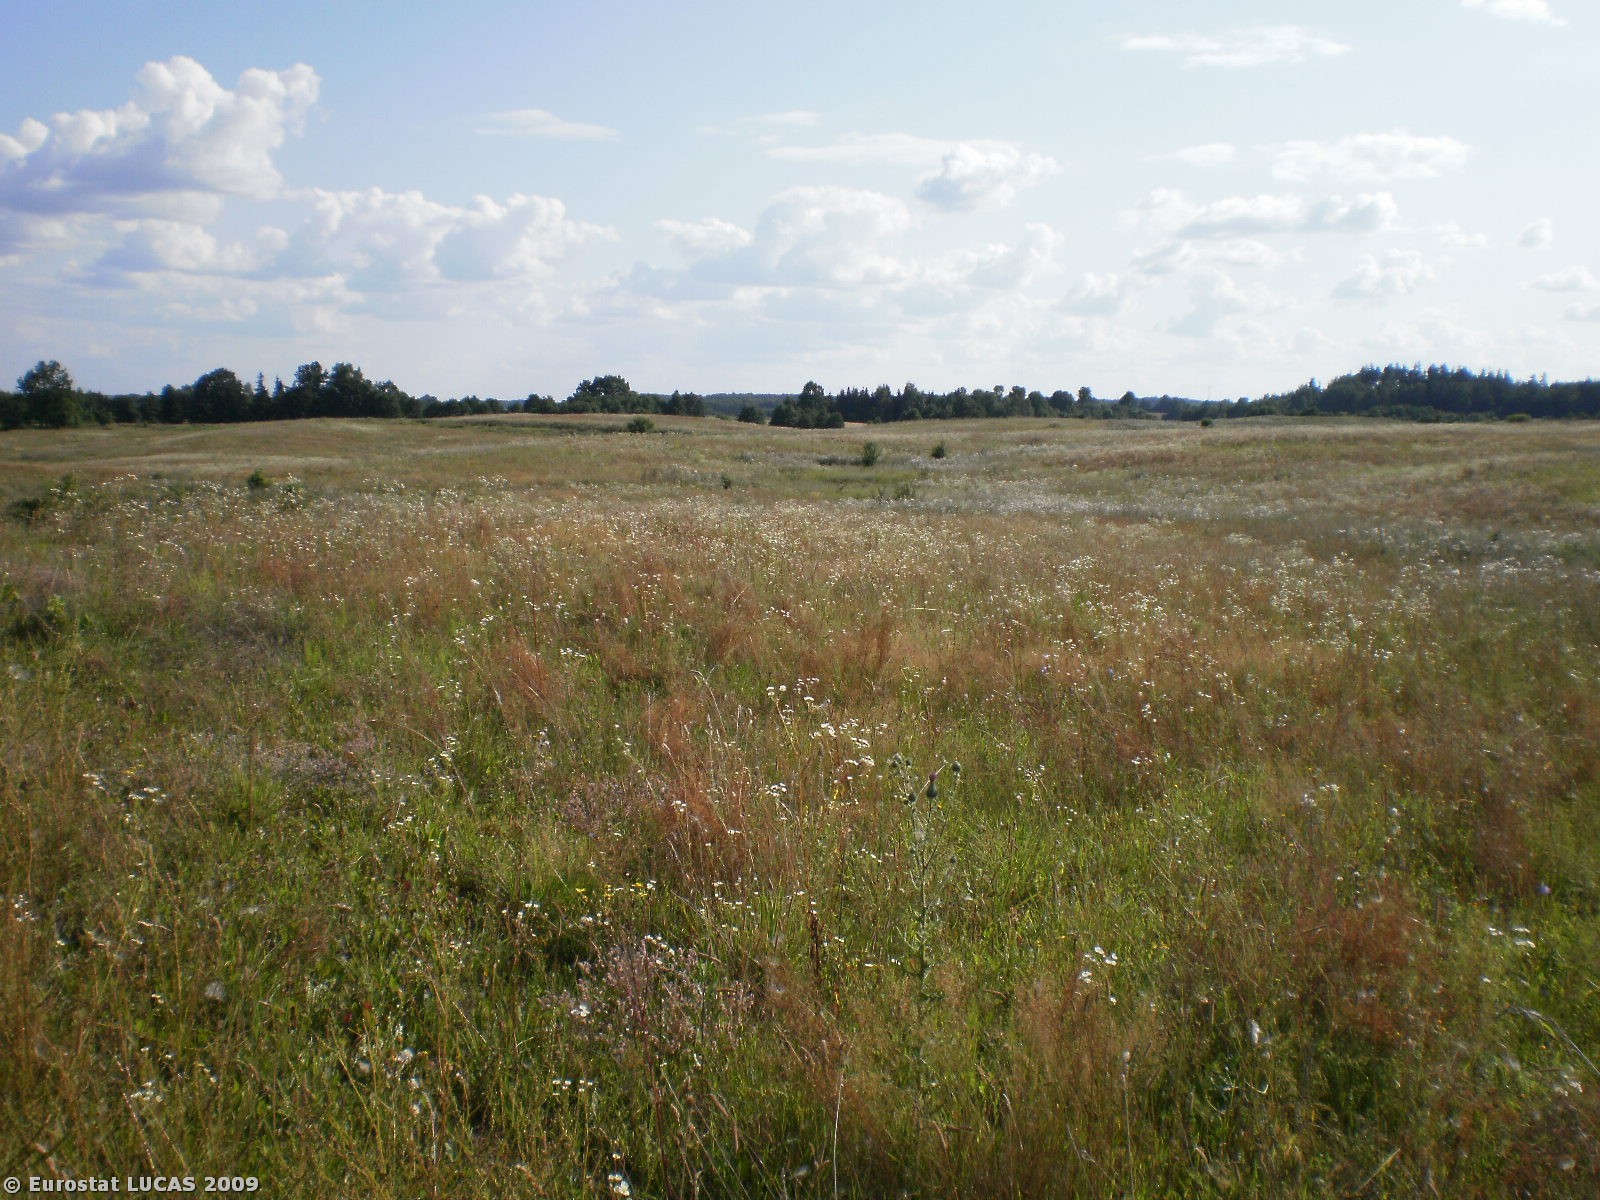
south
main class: Grassland
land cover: Grassland without tree/shrub cover
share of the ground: > 75 %
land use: Fallow land
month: August
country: PL
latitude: 53.8852
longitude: 21.1354
